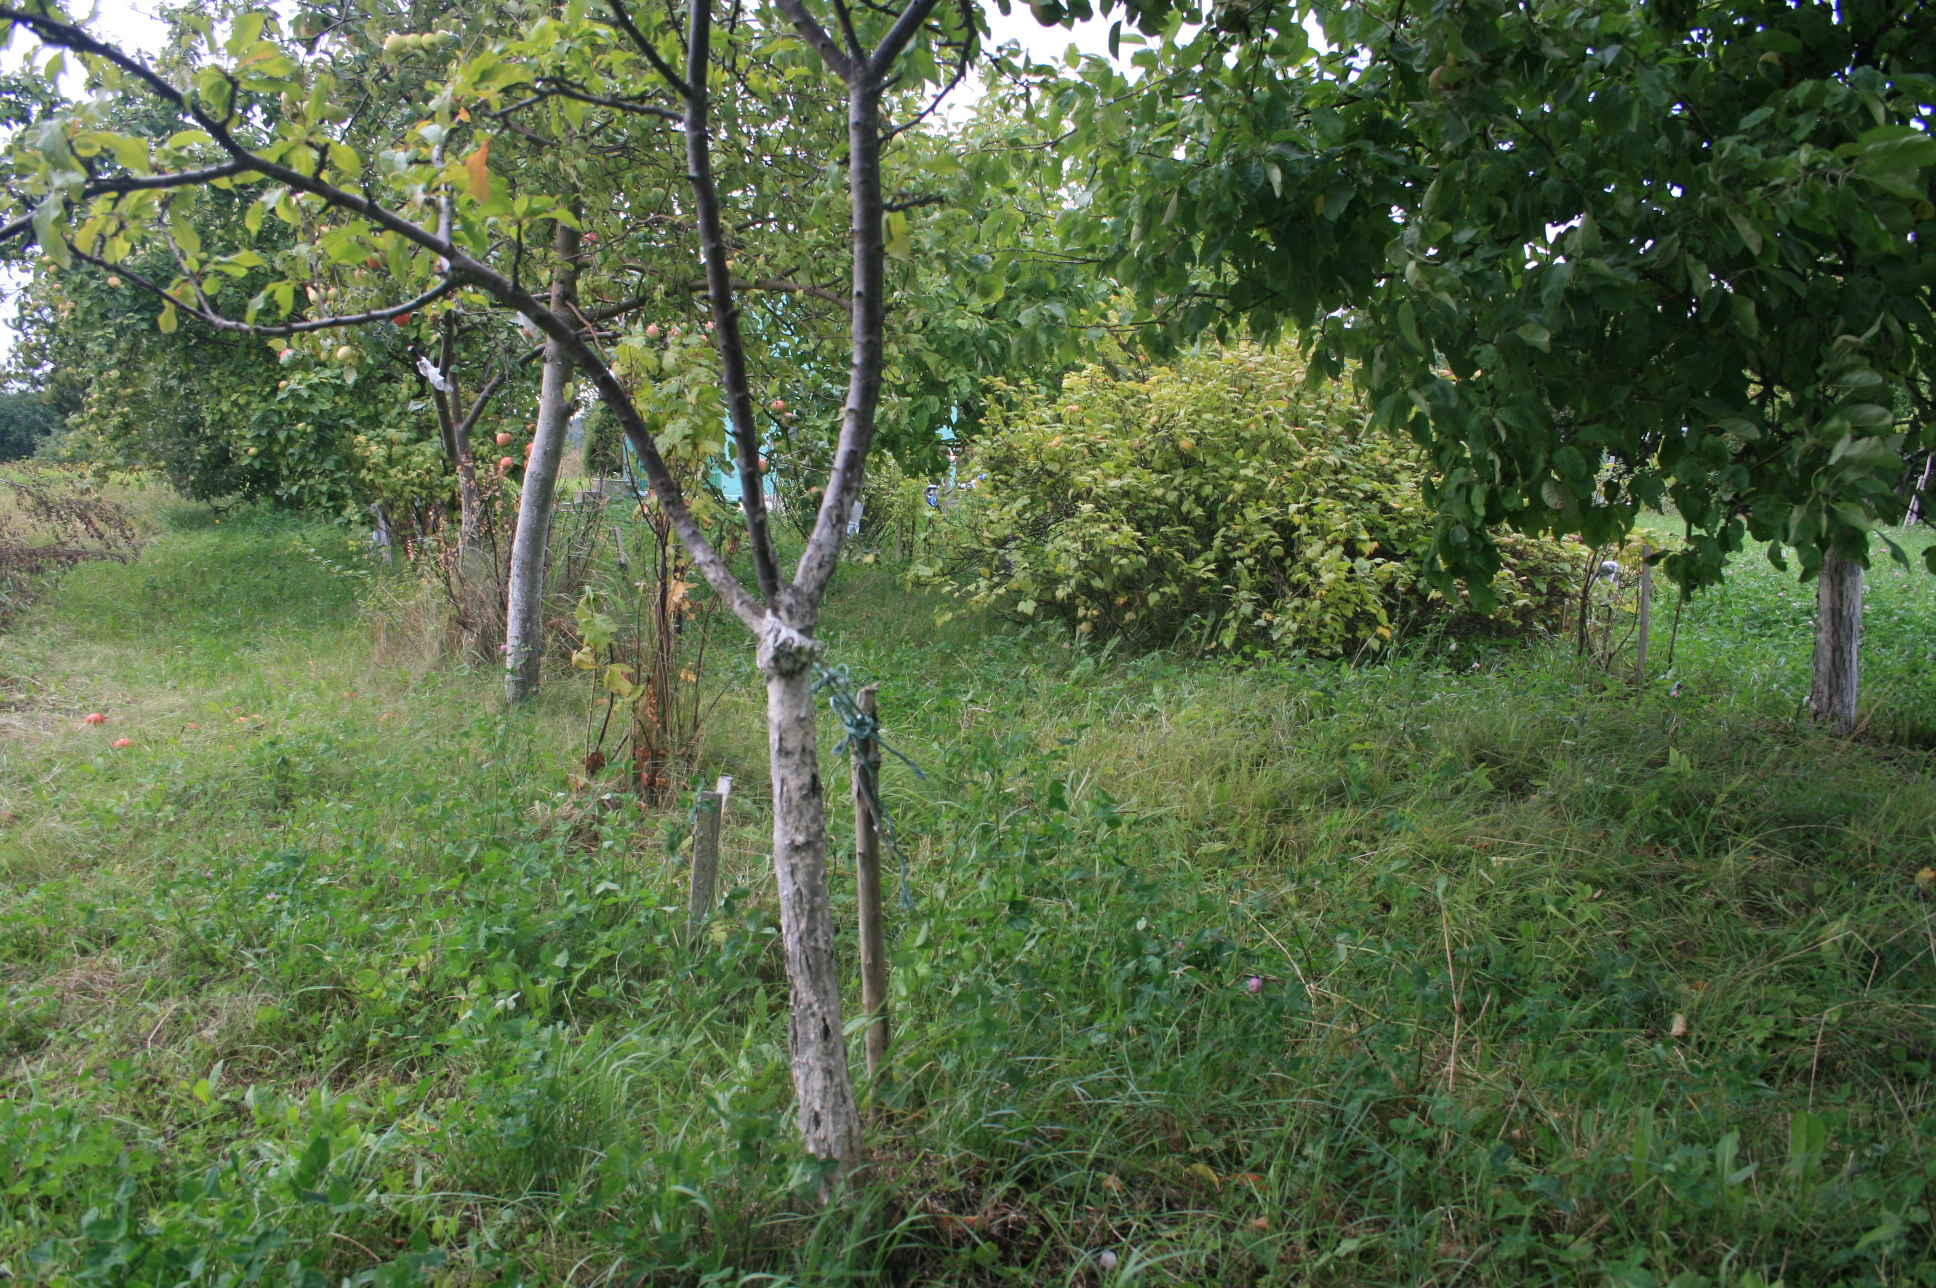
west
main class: Cropland
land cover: Apple fruit
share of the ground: 50 - 75 %
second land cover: Grassland without tree/shrub cover
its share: > 75 %
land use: Kitchen garden
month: September
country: LT
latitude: 55.7028
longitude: 21.3249
